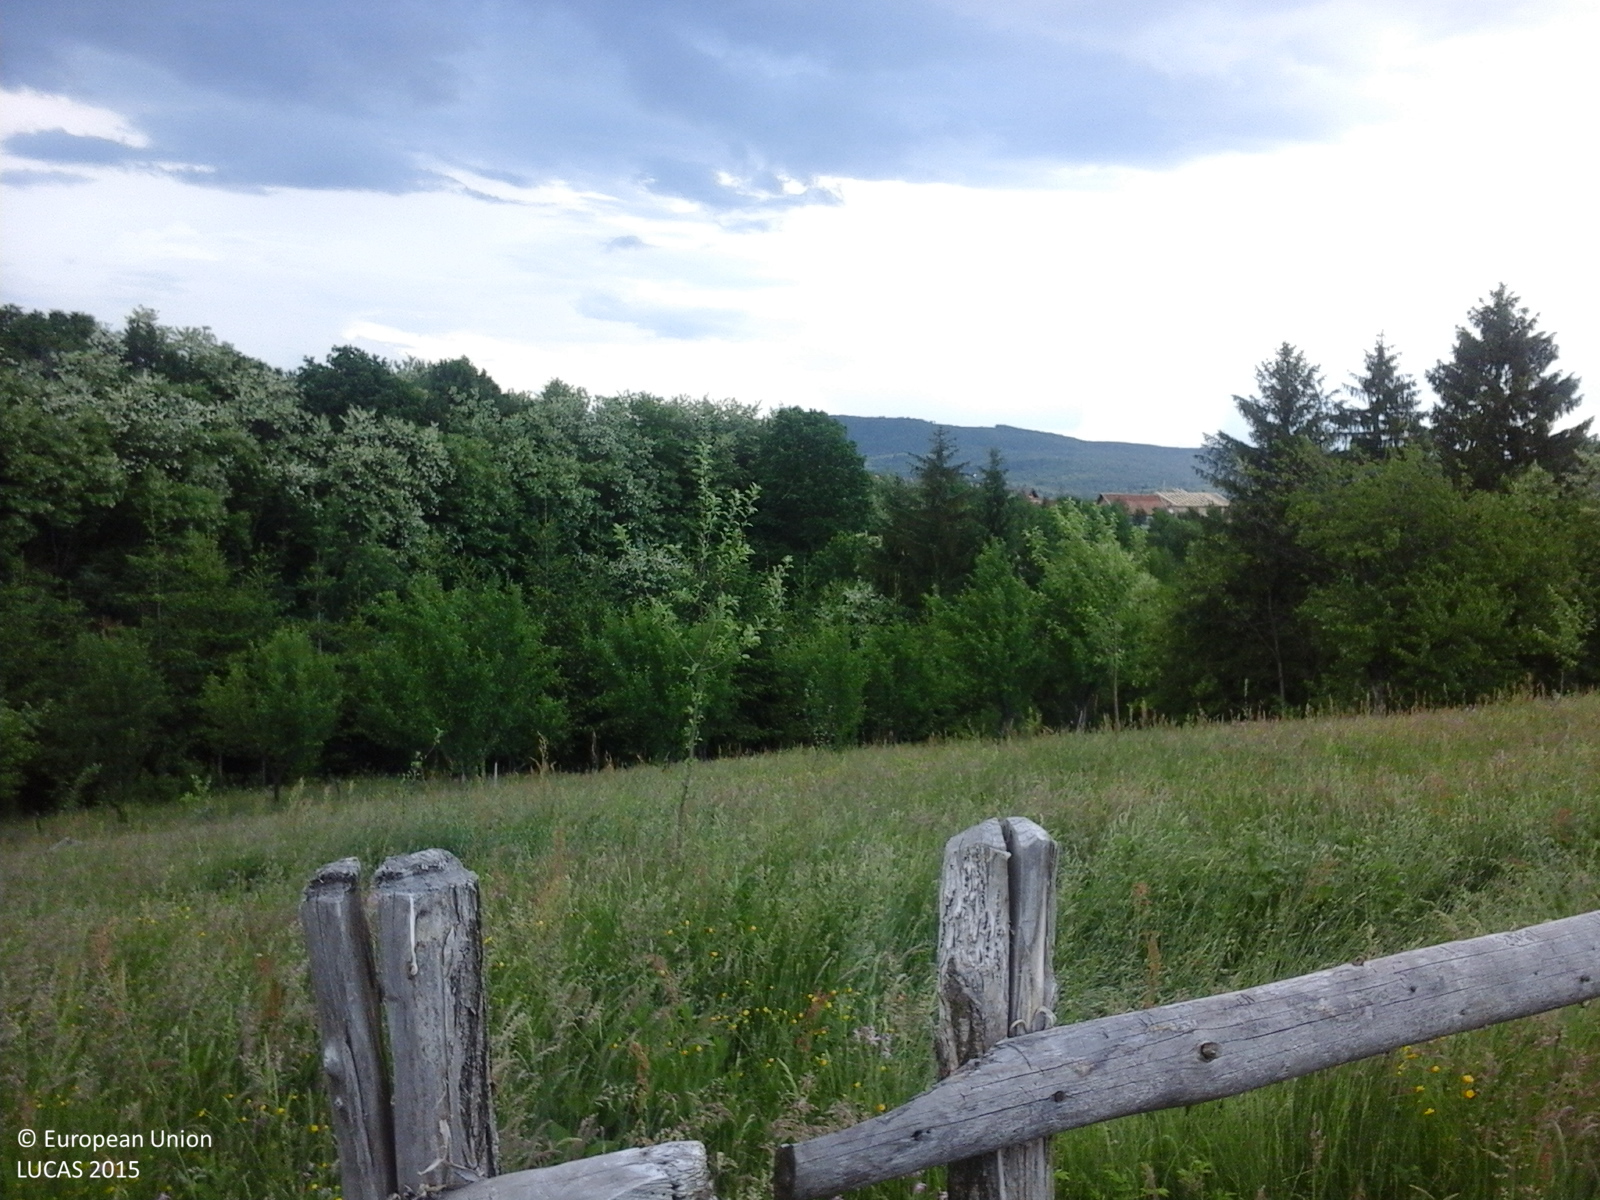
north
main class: Grassland
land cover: Grassland without tree/shrub cover
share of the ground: > 75 %
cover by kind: herbaceous plants 100 %
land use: Agriculture (excluding fallow land and kitchen gardens)
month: May
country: RO
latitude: 45.6913
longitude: 25.2363
